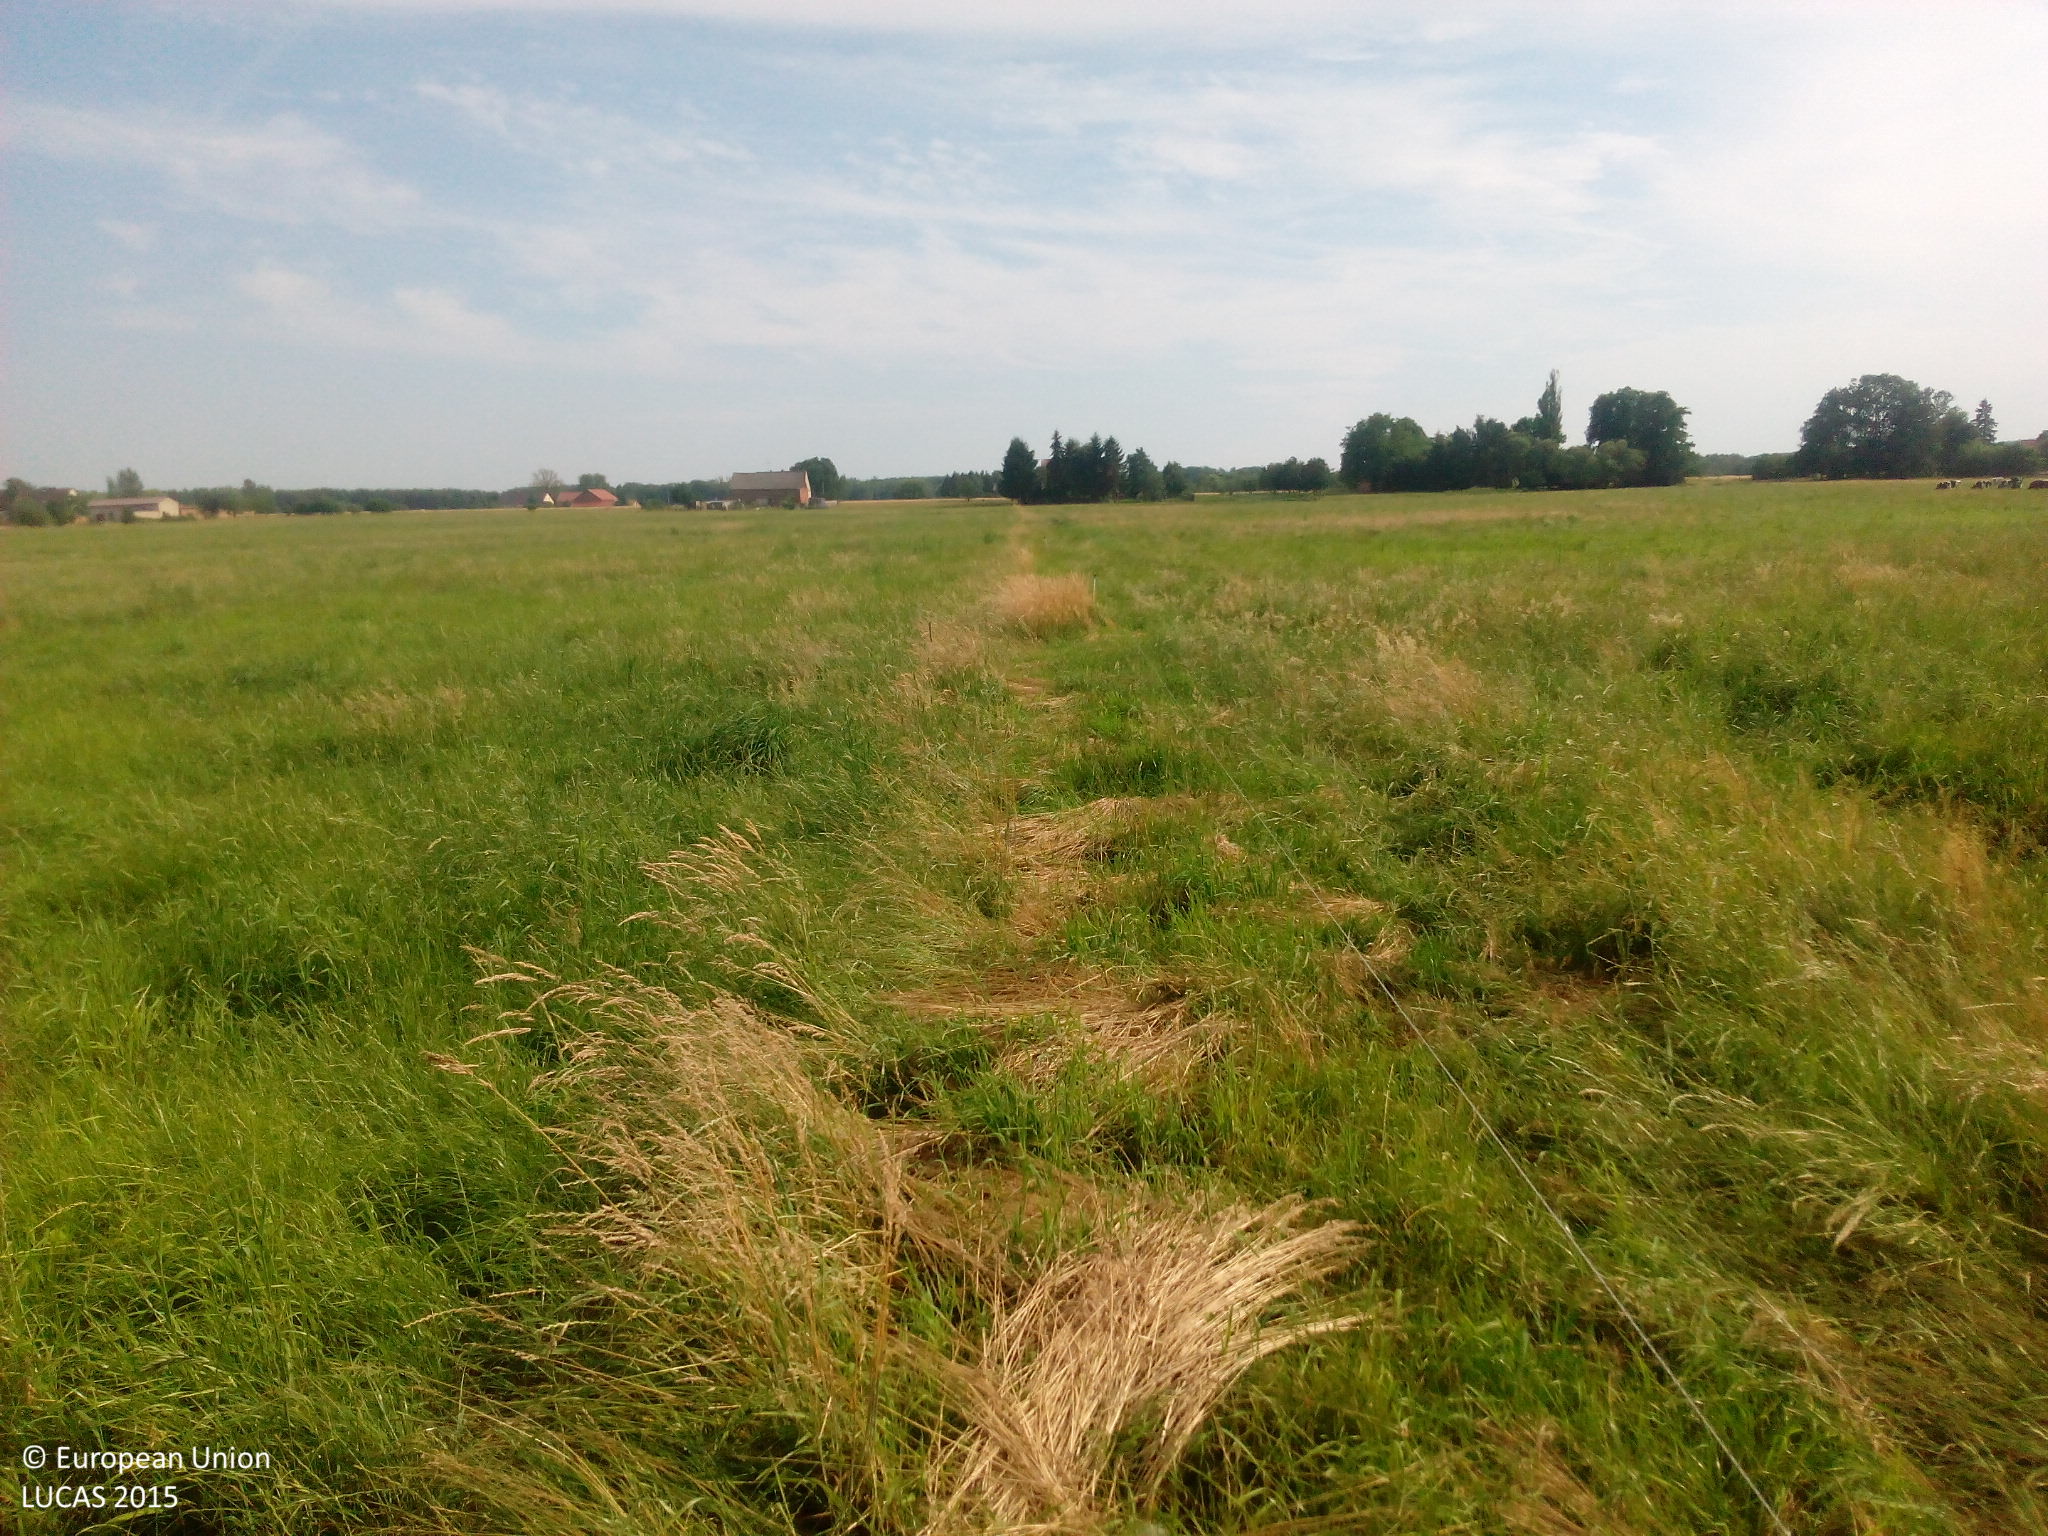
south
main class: Grassland
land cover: Grassland without tree/shrub cover
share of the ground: > 75 %
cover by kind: herbaceous plants 100 %
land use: Agriculture (excluding fallow land and kitchen gardens)
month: July
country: DE
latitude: 52.7659
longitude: 12.4449
